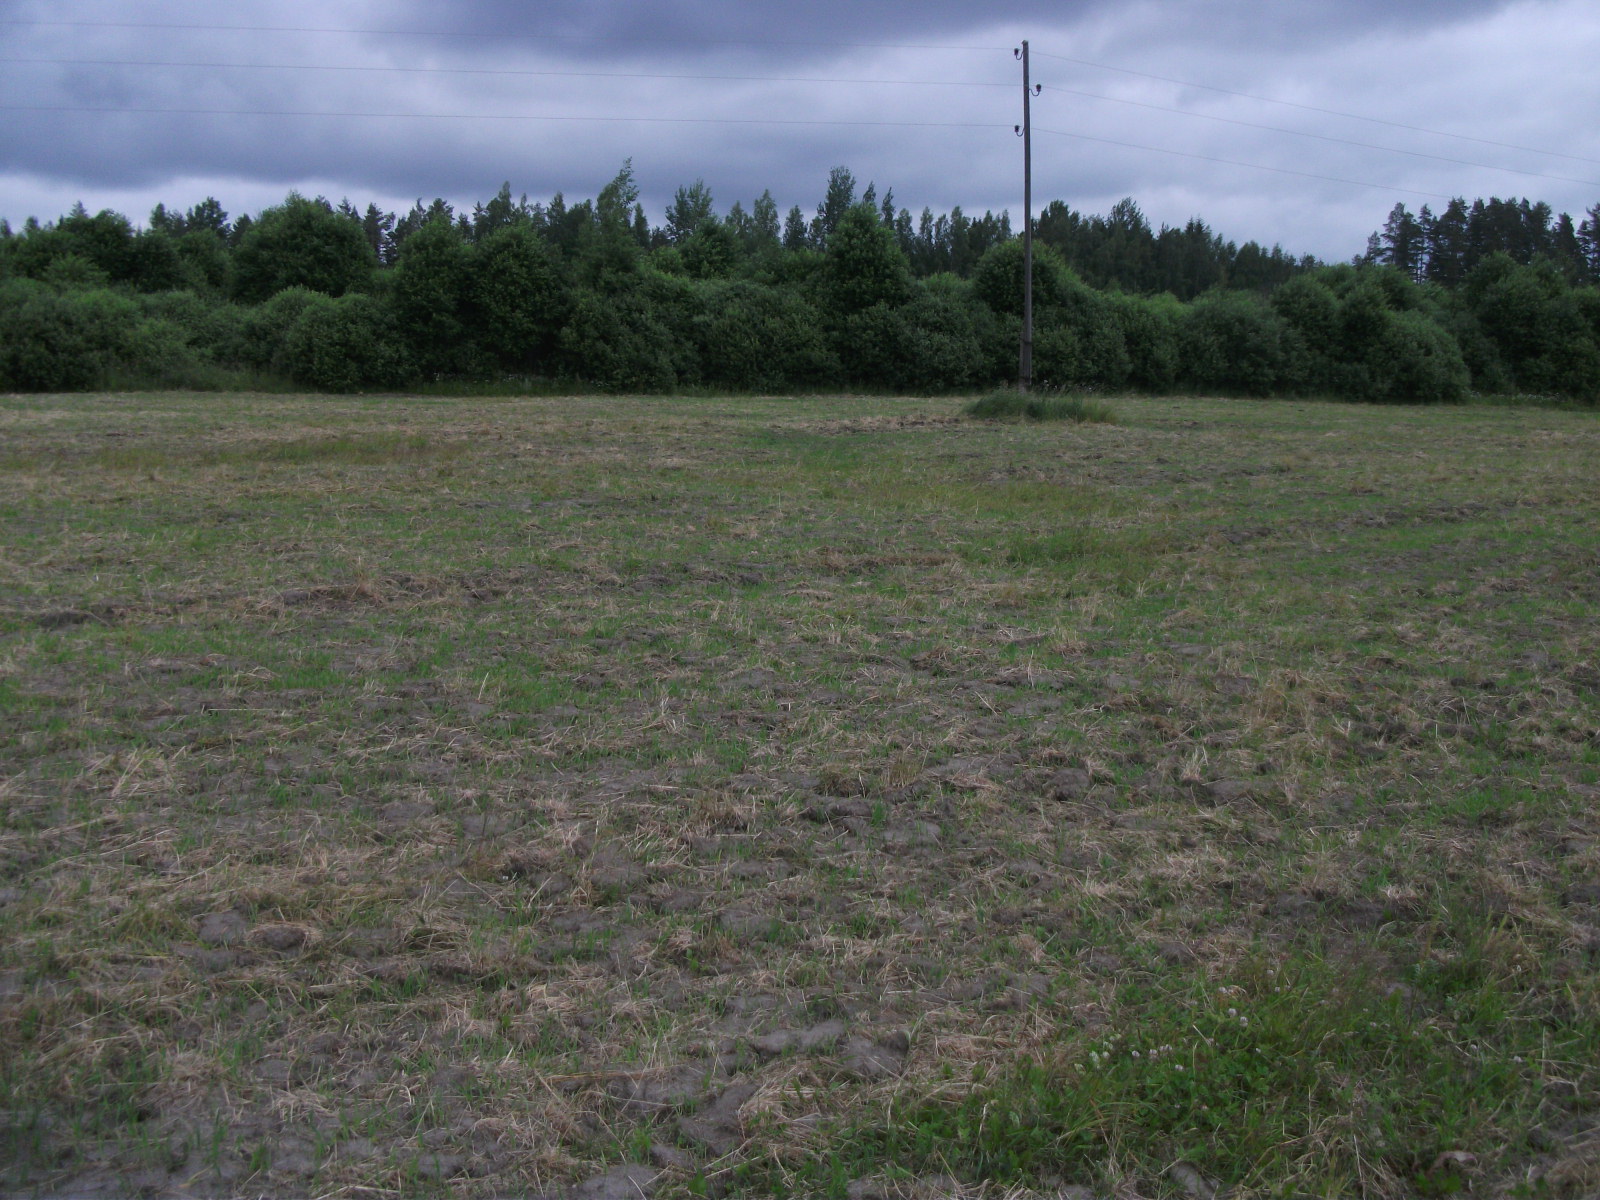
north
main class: Grassland
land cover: Grassland without tree/shrub cover
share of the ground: 50 - 75 %
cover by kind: herbaceous plants 70 %, unconsolidated bare surface 30 %
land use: Agriculture (excluding fallow land and kitchen gardens)
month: January
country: LV
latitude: 56.8890
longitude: 26.6800
